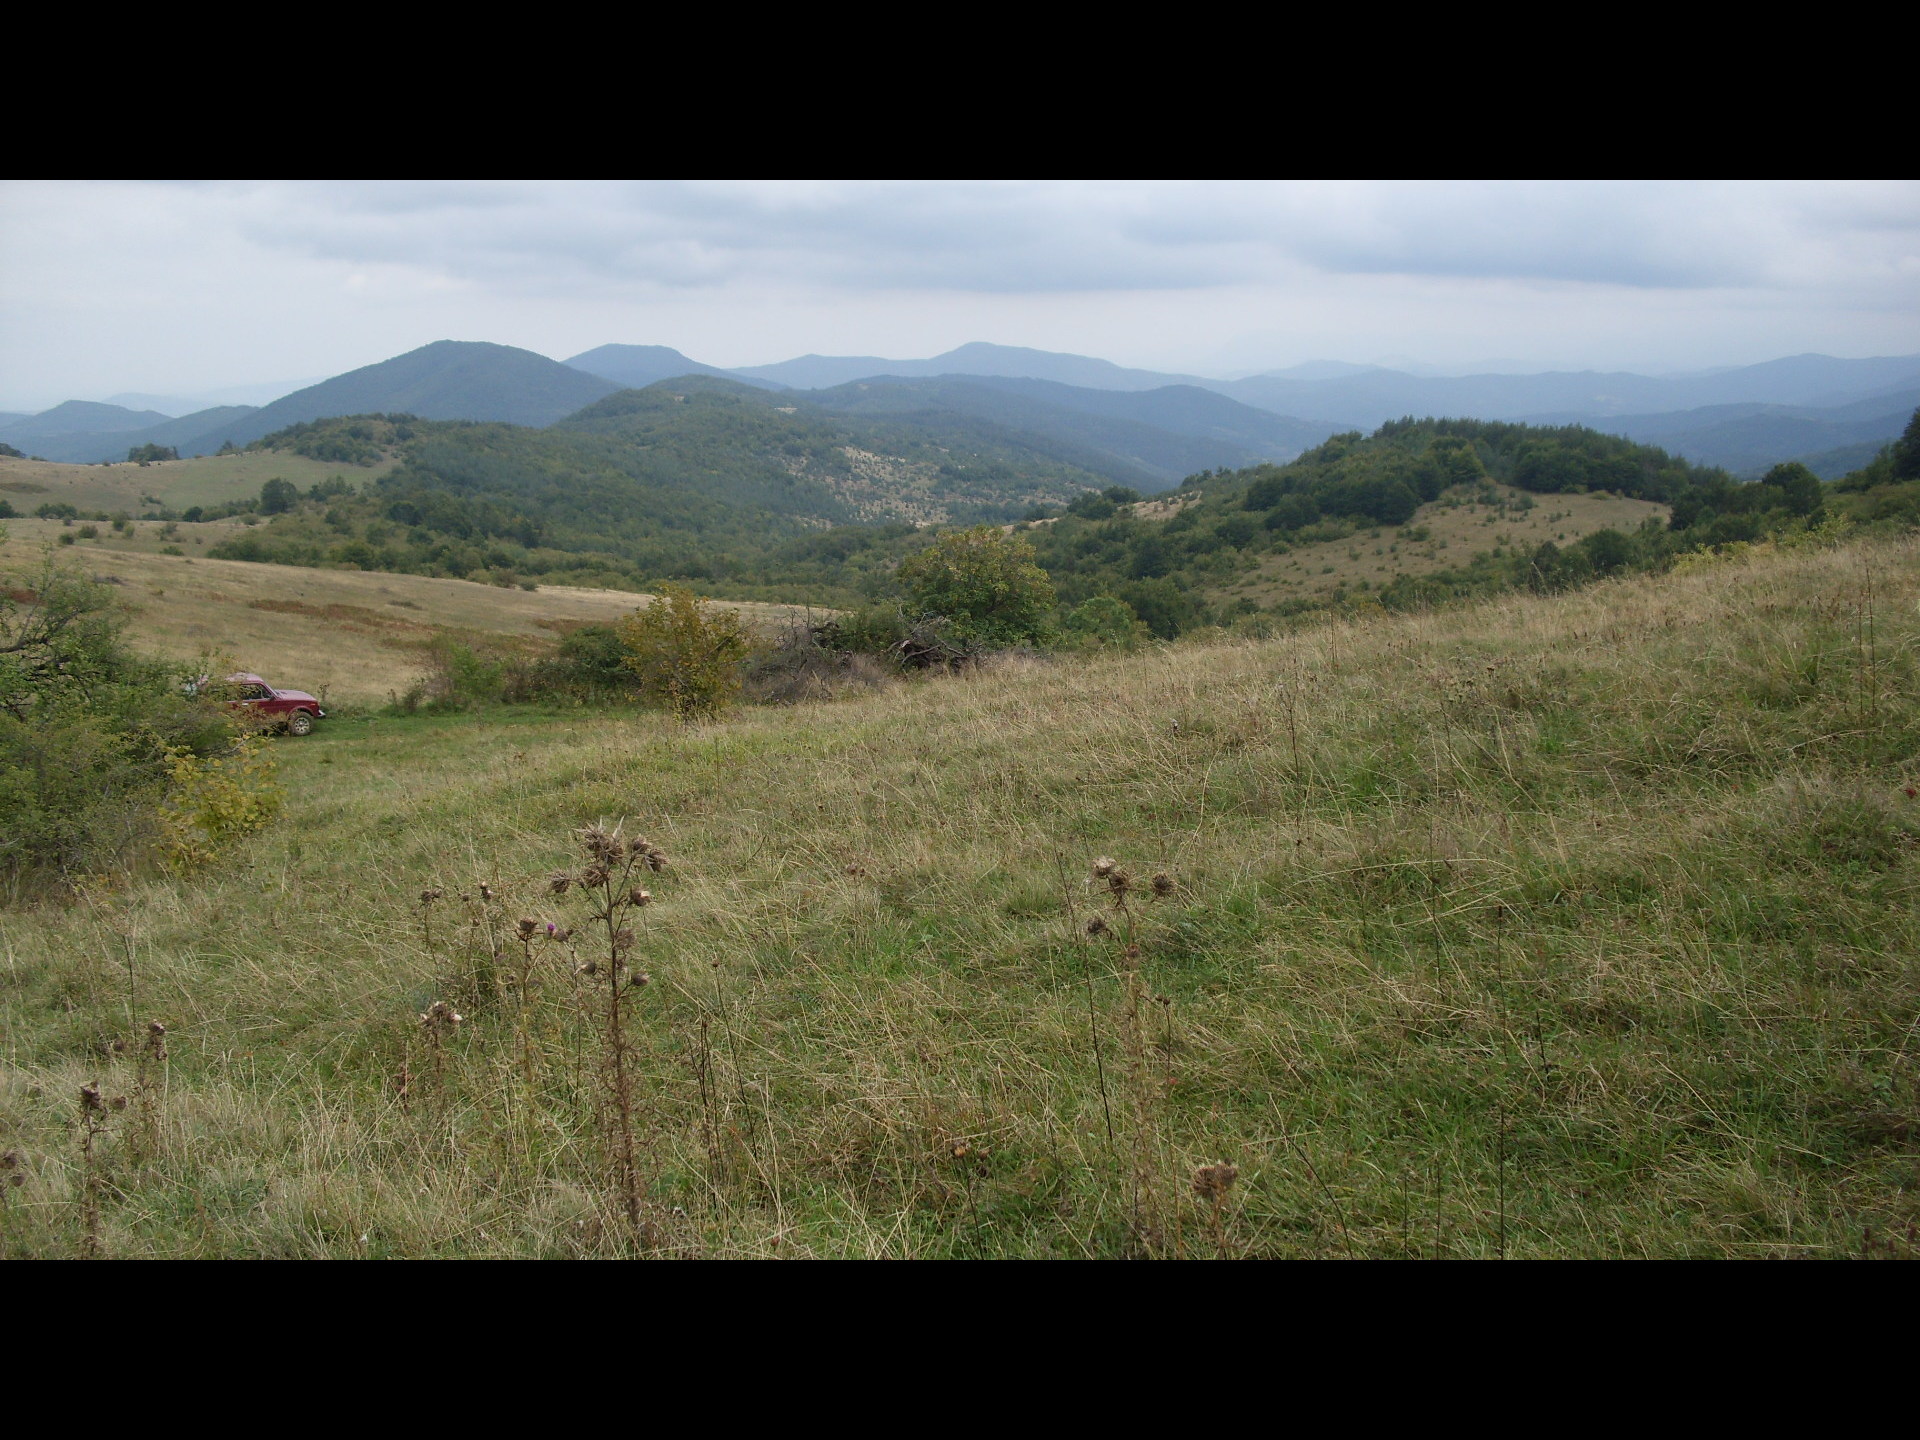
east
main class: Grassland
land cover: Grassland with sparse tree/shrub cover
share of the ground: > 75 %
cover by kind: herbaceous plants 90 %, broadleaved forest trees 5 %, shrubs 5 %
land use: Agriculture (excluding fallow land and kitchen gardens)
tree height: < 5 m
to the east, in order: Grassland with sparse tree/shrub cover; Tracks; Single bushes/trees; Grassland without tree/shrub cover; Grassland with sparse tree/shrub cover; Grassland without tree/shrub cover
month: October
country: BG
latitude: 43.3470
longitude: 22.8512
